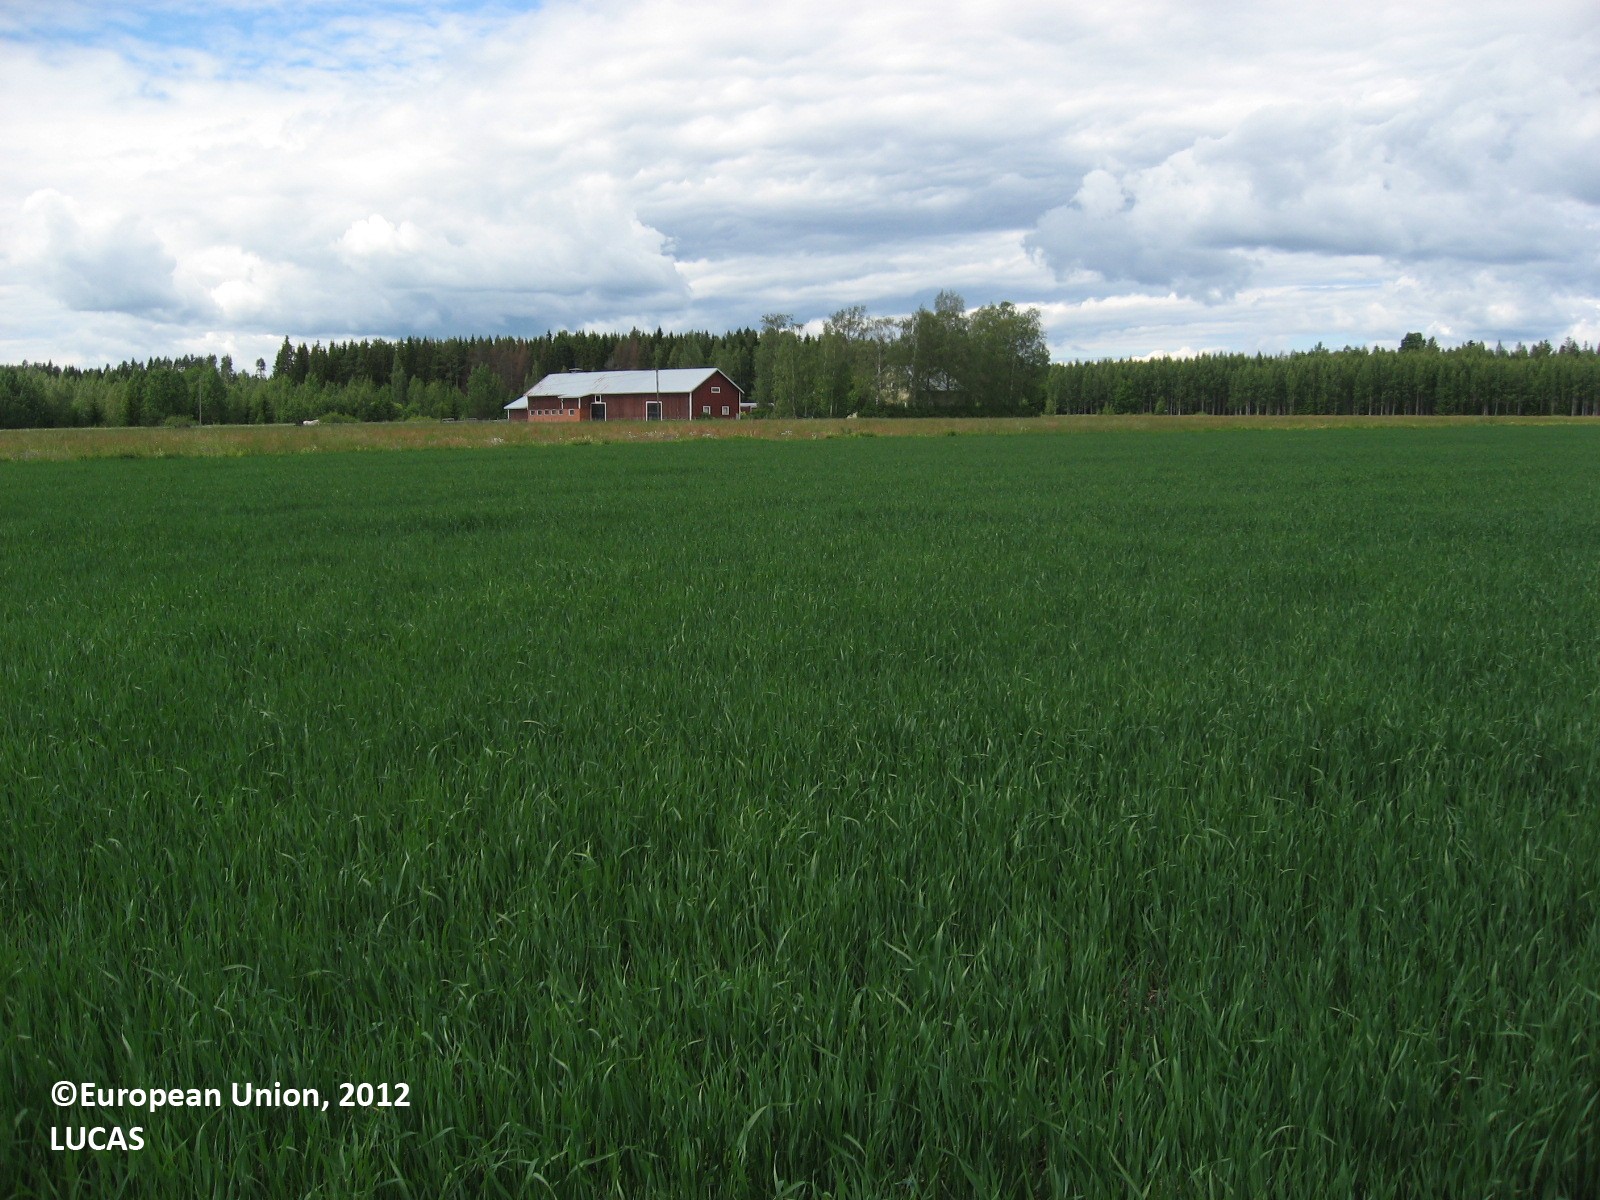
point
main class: Cropland
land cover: Oats
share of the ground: > 75 %
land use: Agriculture (excluding fallow land and kitchen gardens)
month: June
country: FI
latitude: 60.7623
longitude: 26.5452
